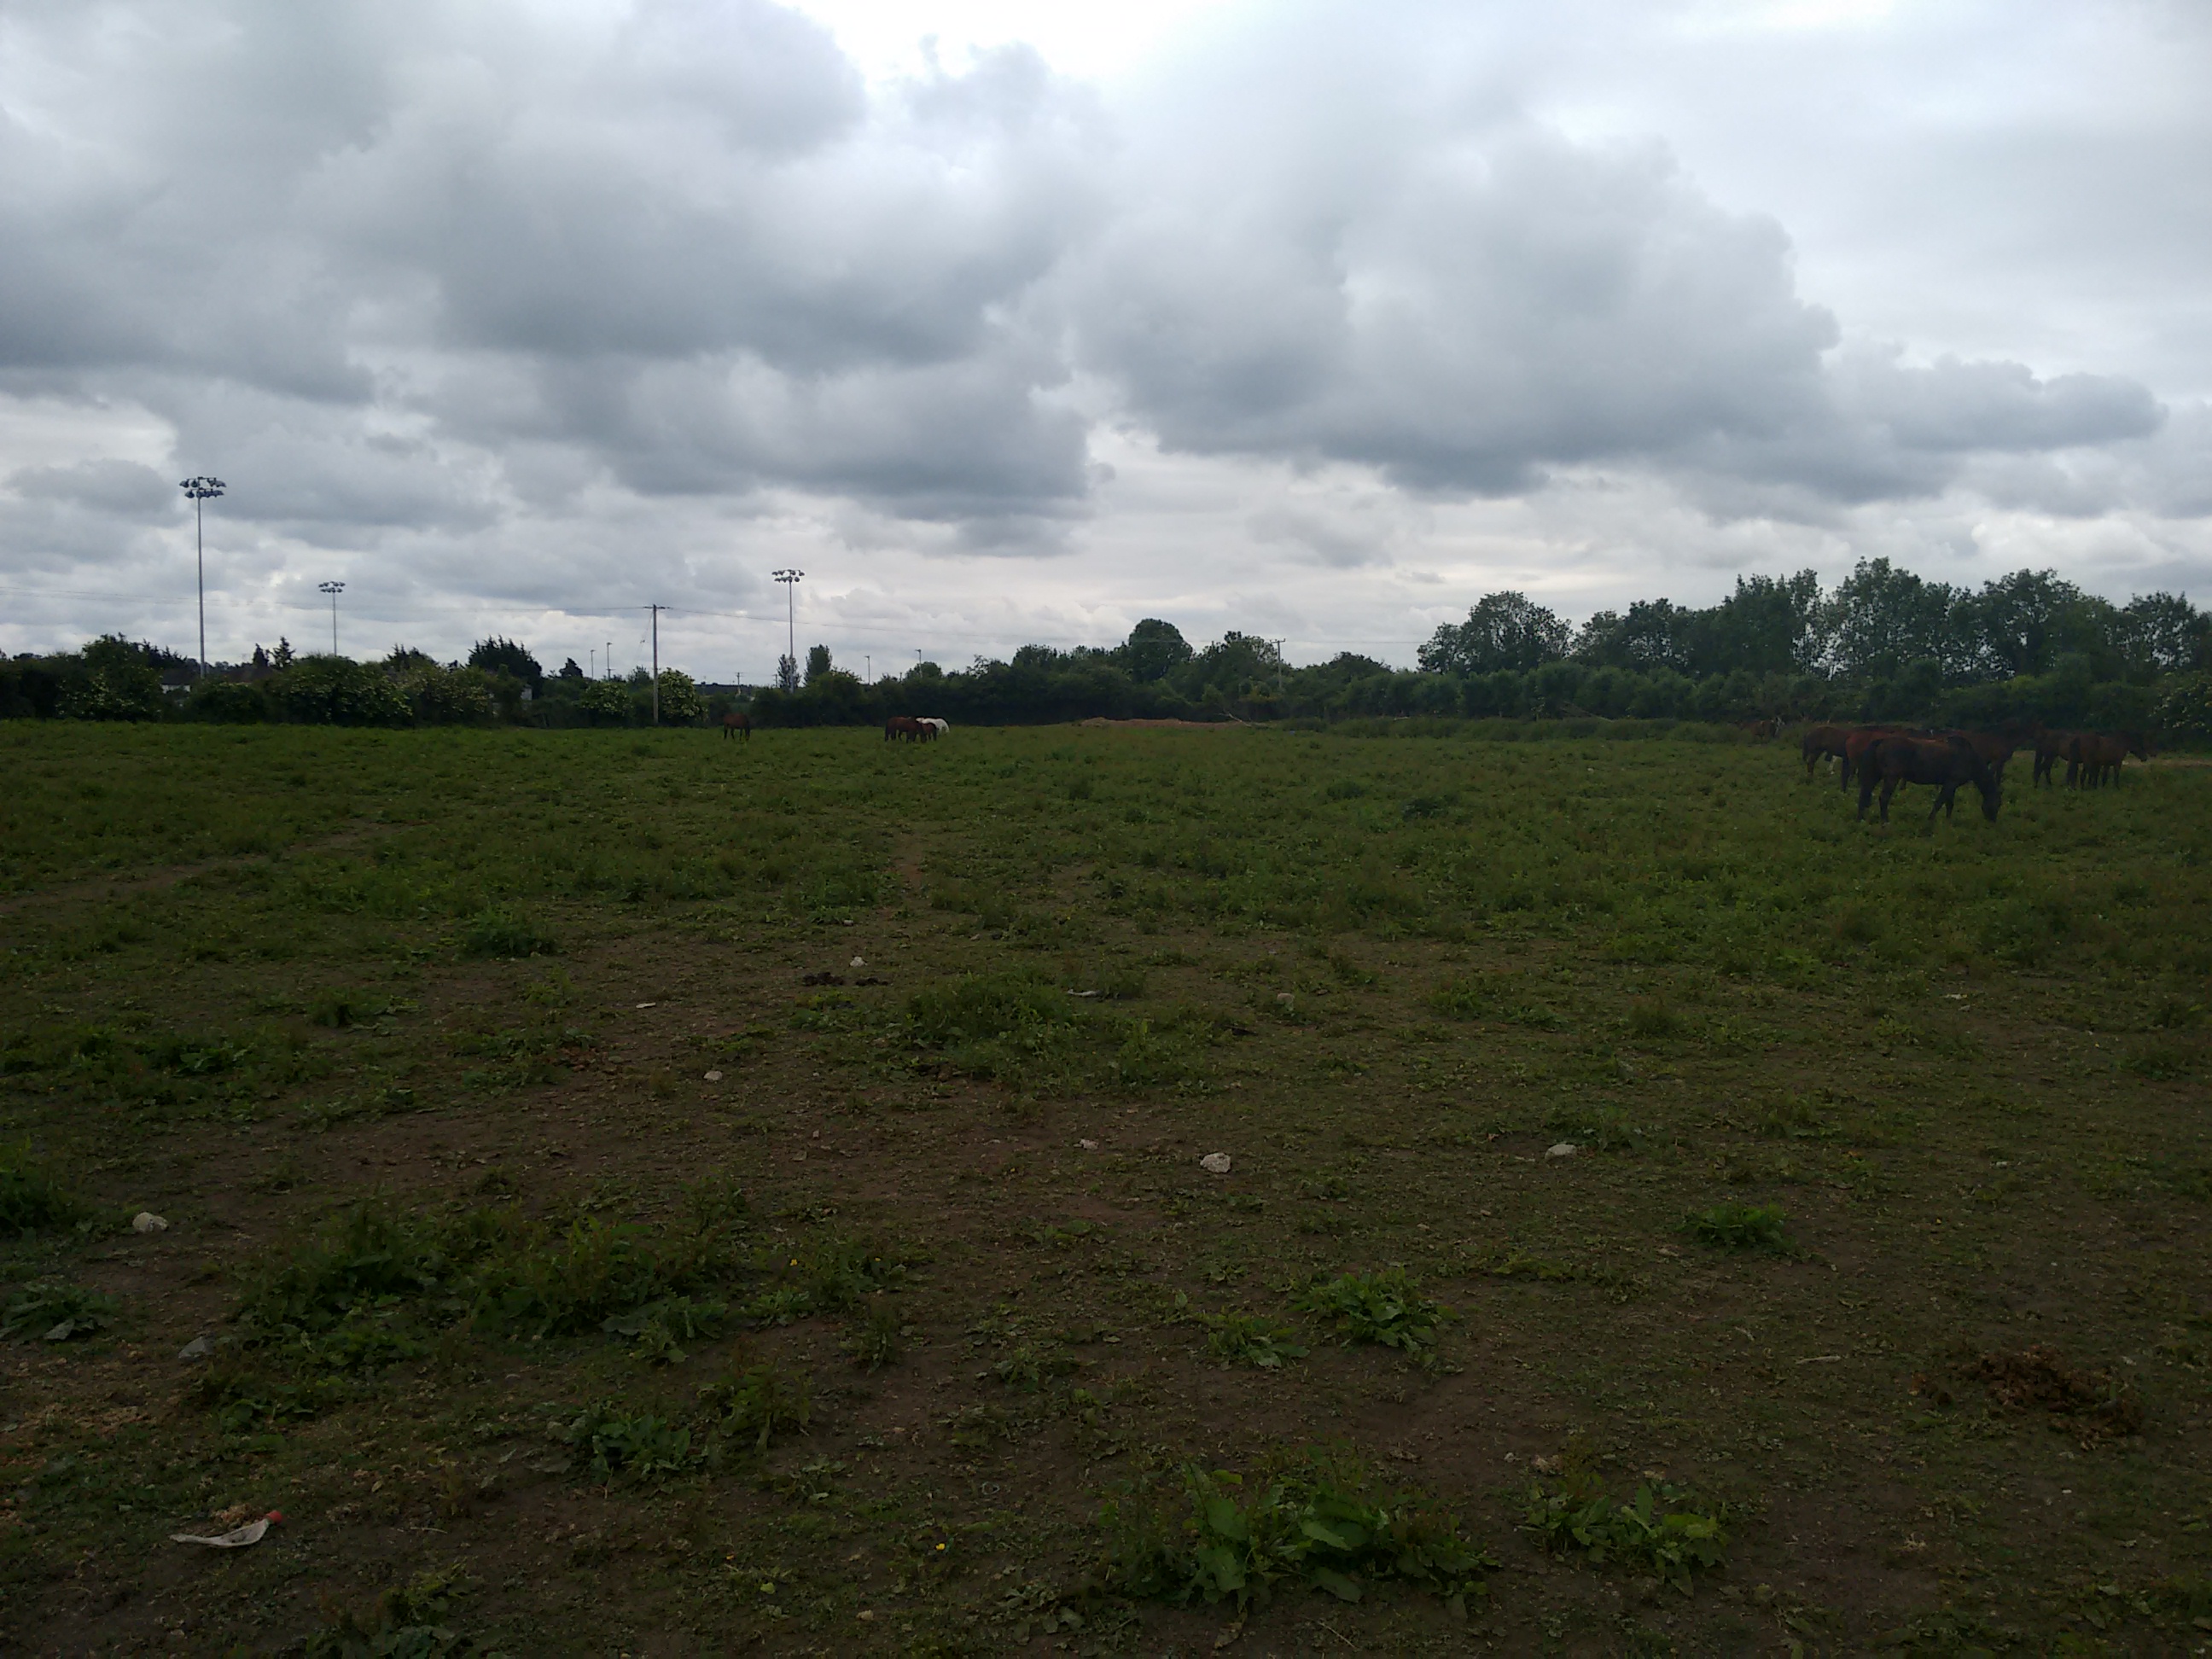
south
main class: Grassland
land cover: Spontaneously vegetated surfaces
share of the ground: > 75 %
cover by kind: herbaceous plants 50 %, consolidated bare surface 45 %, shrubs 5 %
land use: Agriculture (excluding fallow land and kitchen gardens)
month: June
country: IE
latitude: 53.4154
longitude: -7.9108
